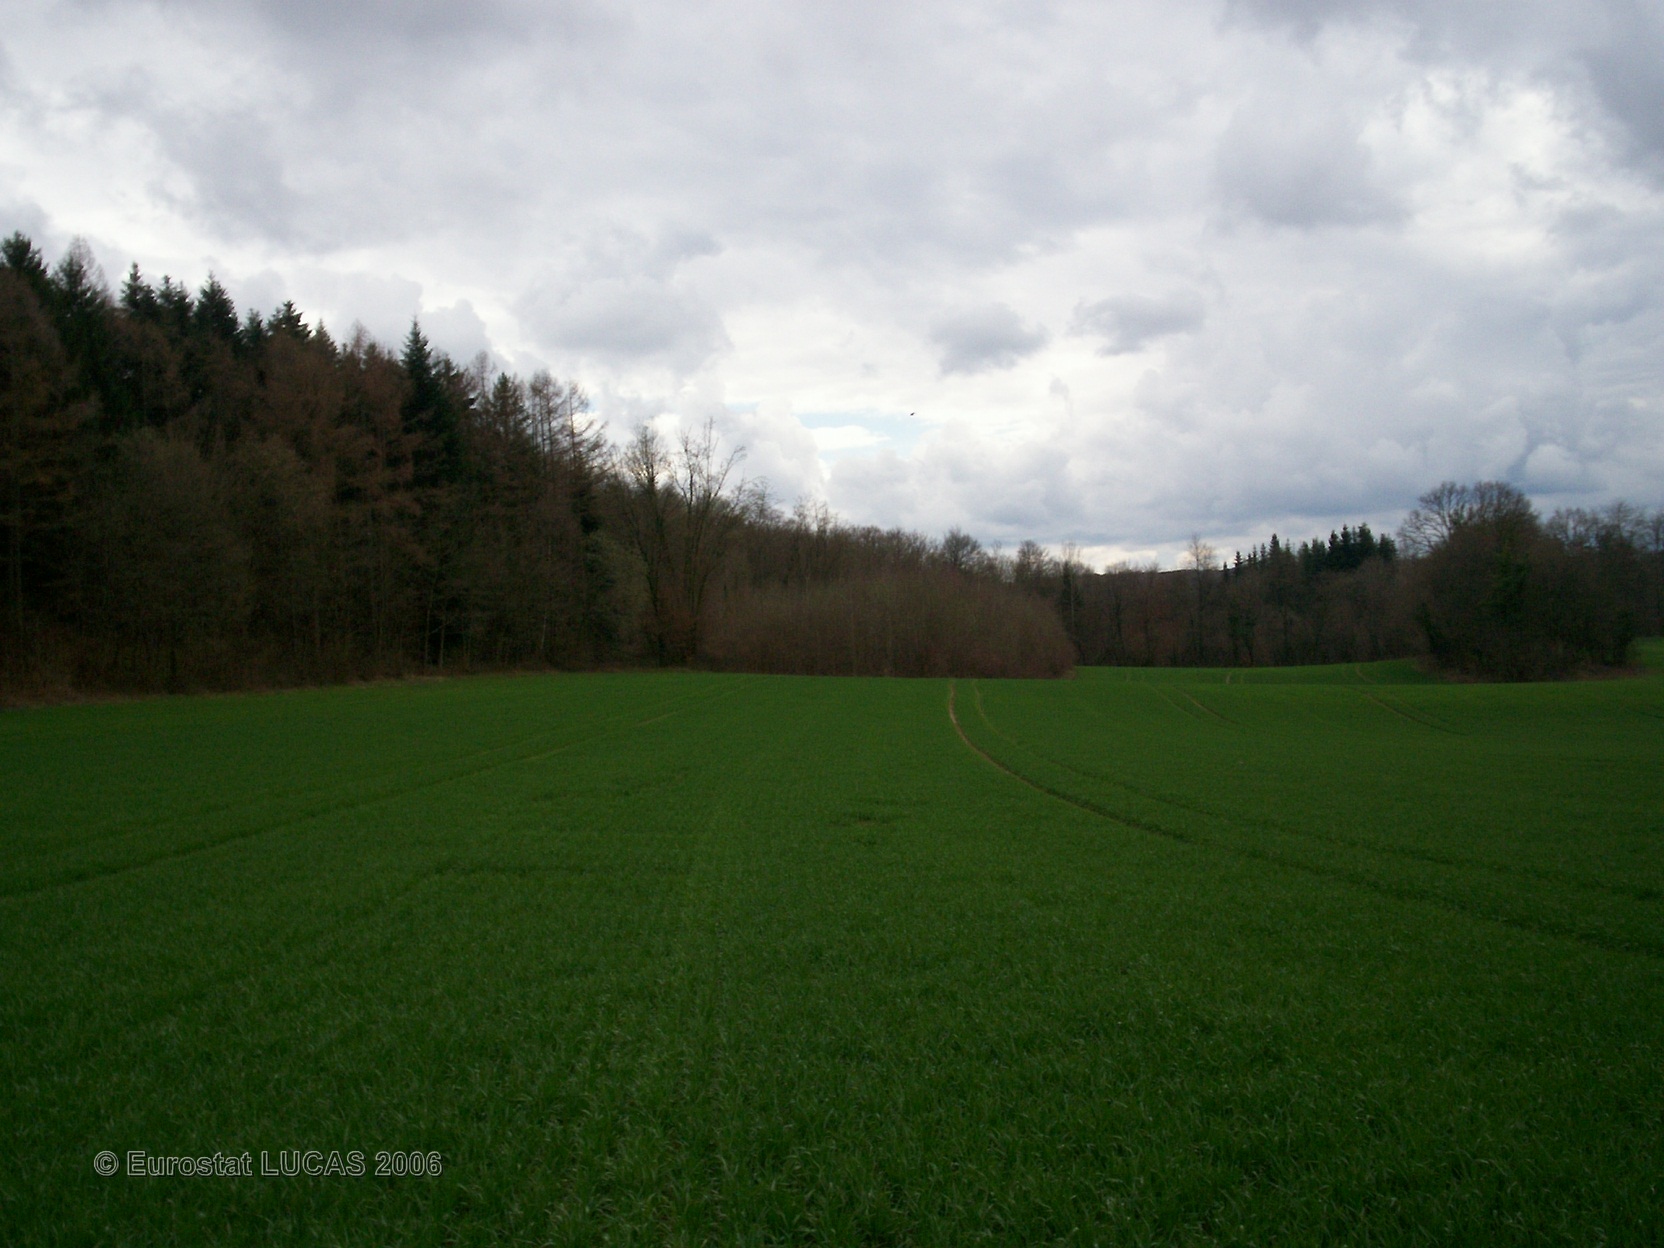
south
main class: Cropland
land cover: Common wheat
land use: Agriculture (excluding fallow land and kitchen gardens)
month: April
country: FR
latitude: 47.5043
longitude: 6.5896
